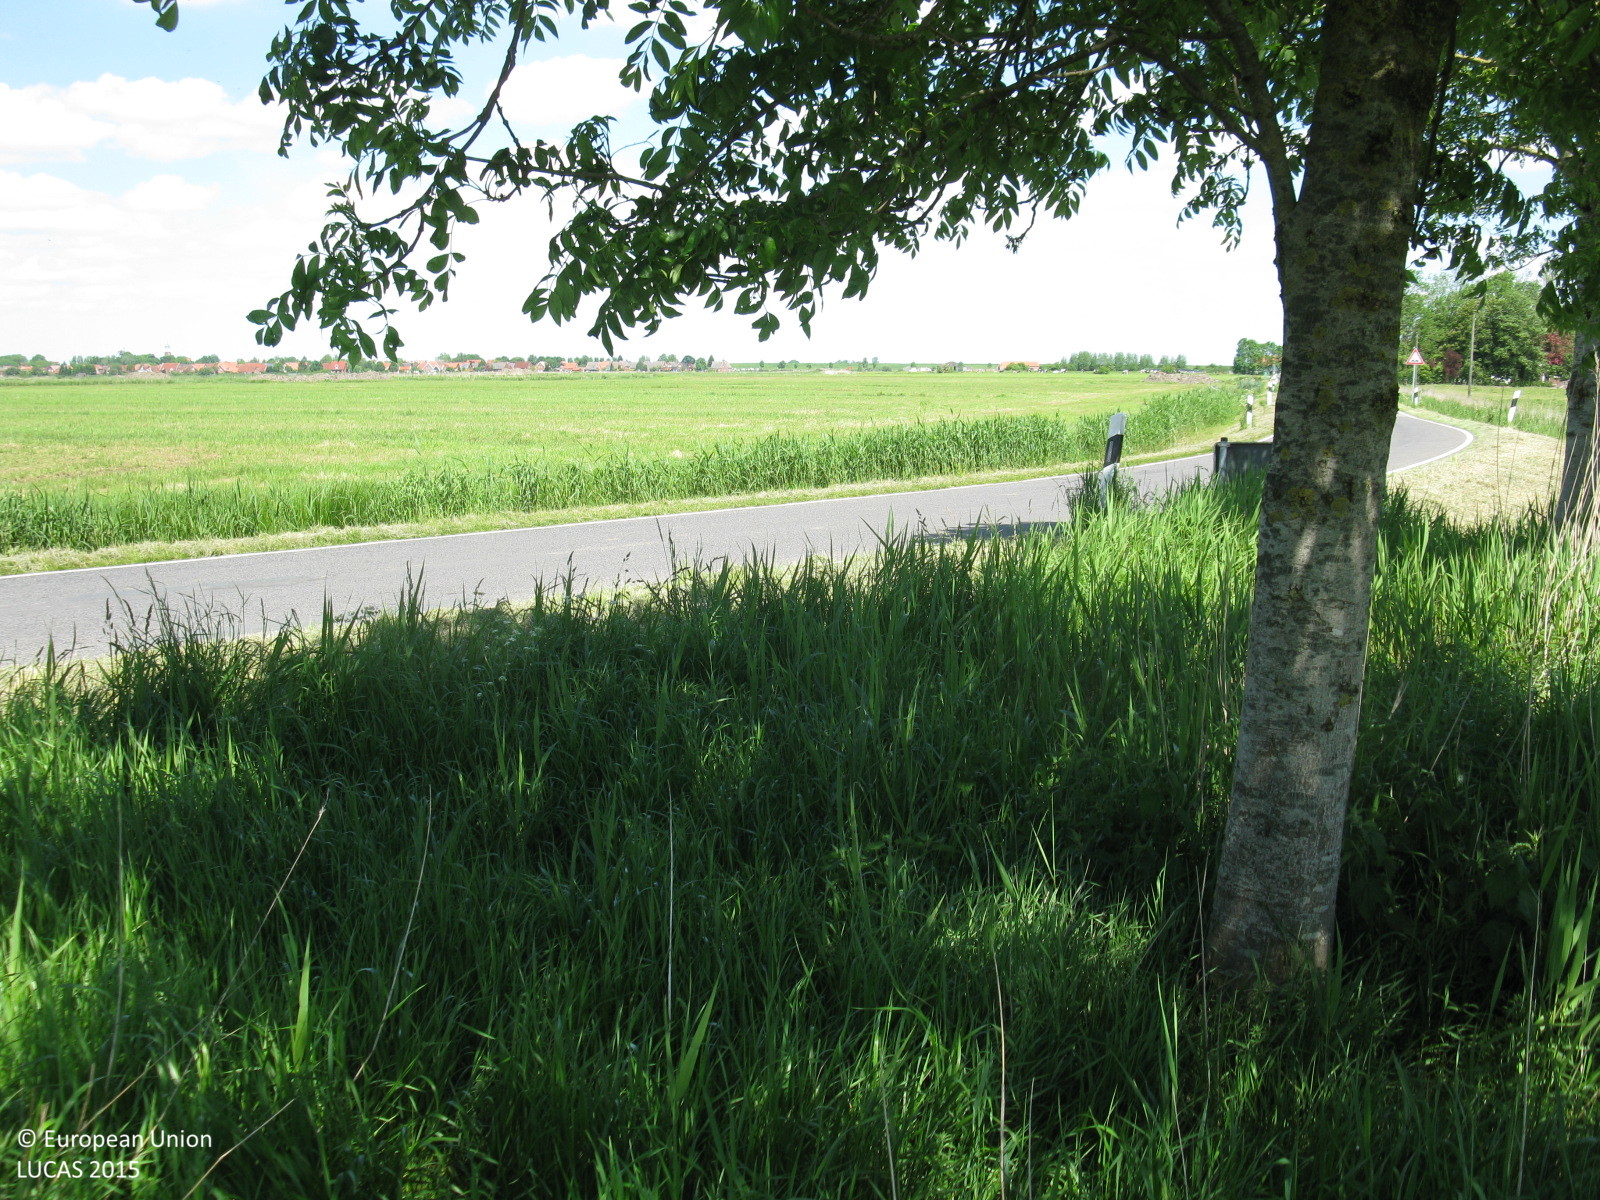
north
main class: Grassland
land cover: Grassland without tree/shrub cover
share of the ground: > 75 %
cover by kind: herbaceous plants 100 %
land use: Agriculture (excluding fallow land and kitchen gardens)
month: June
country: DE
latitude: 53.2996
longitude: 7.2847
